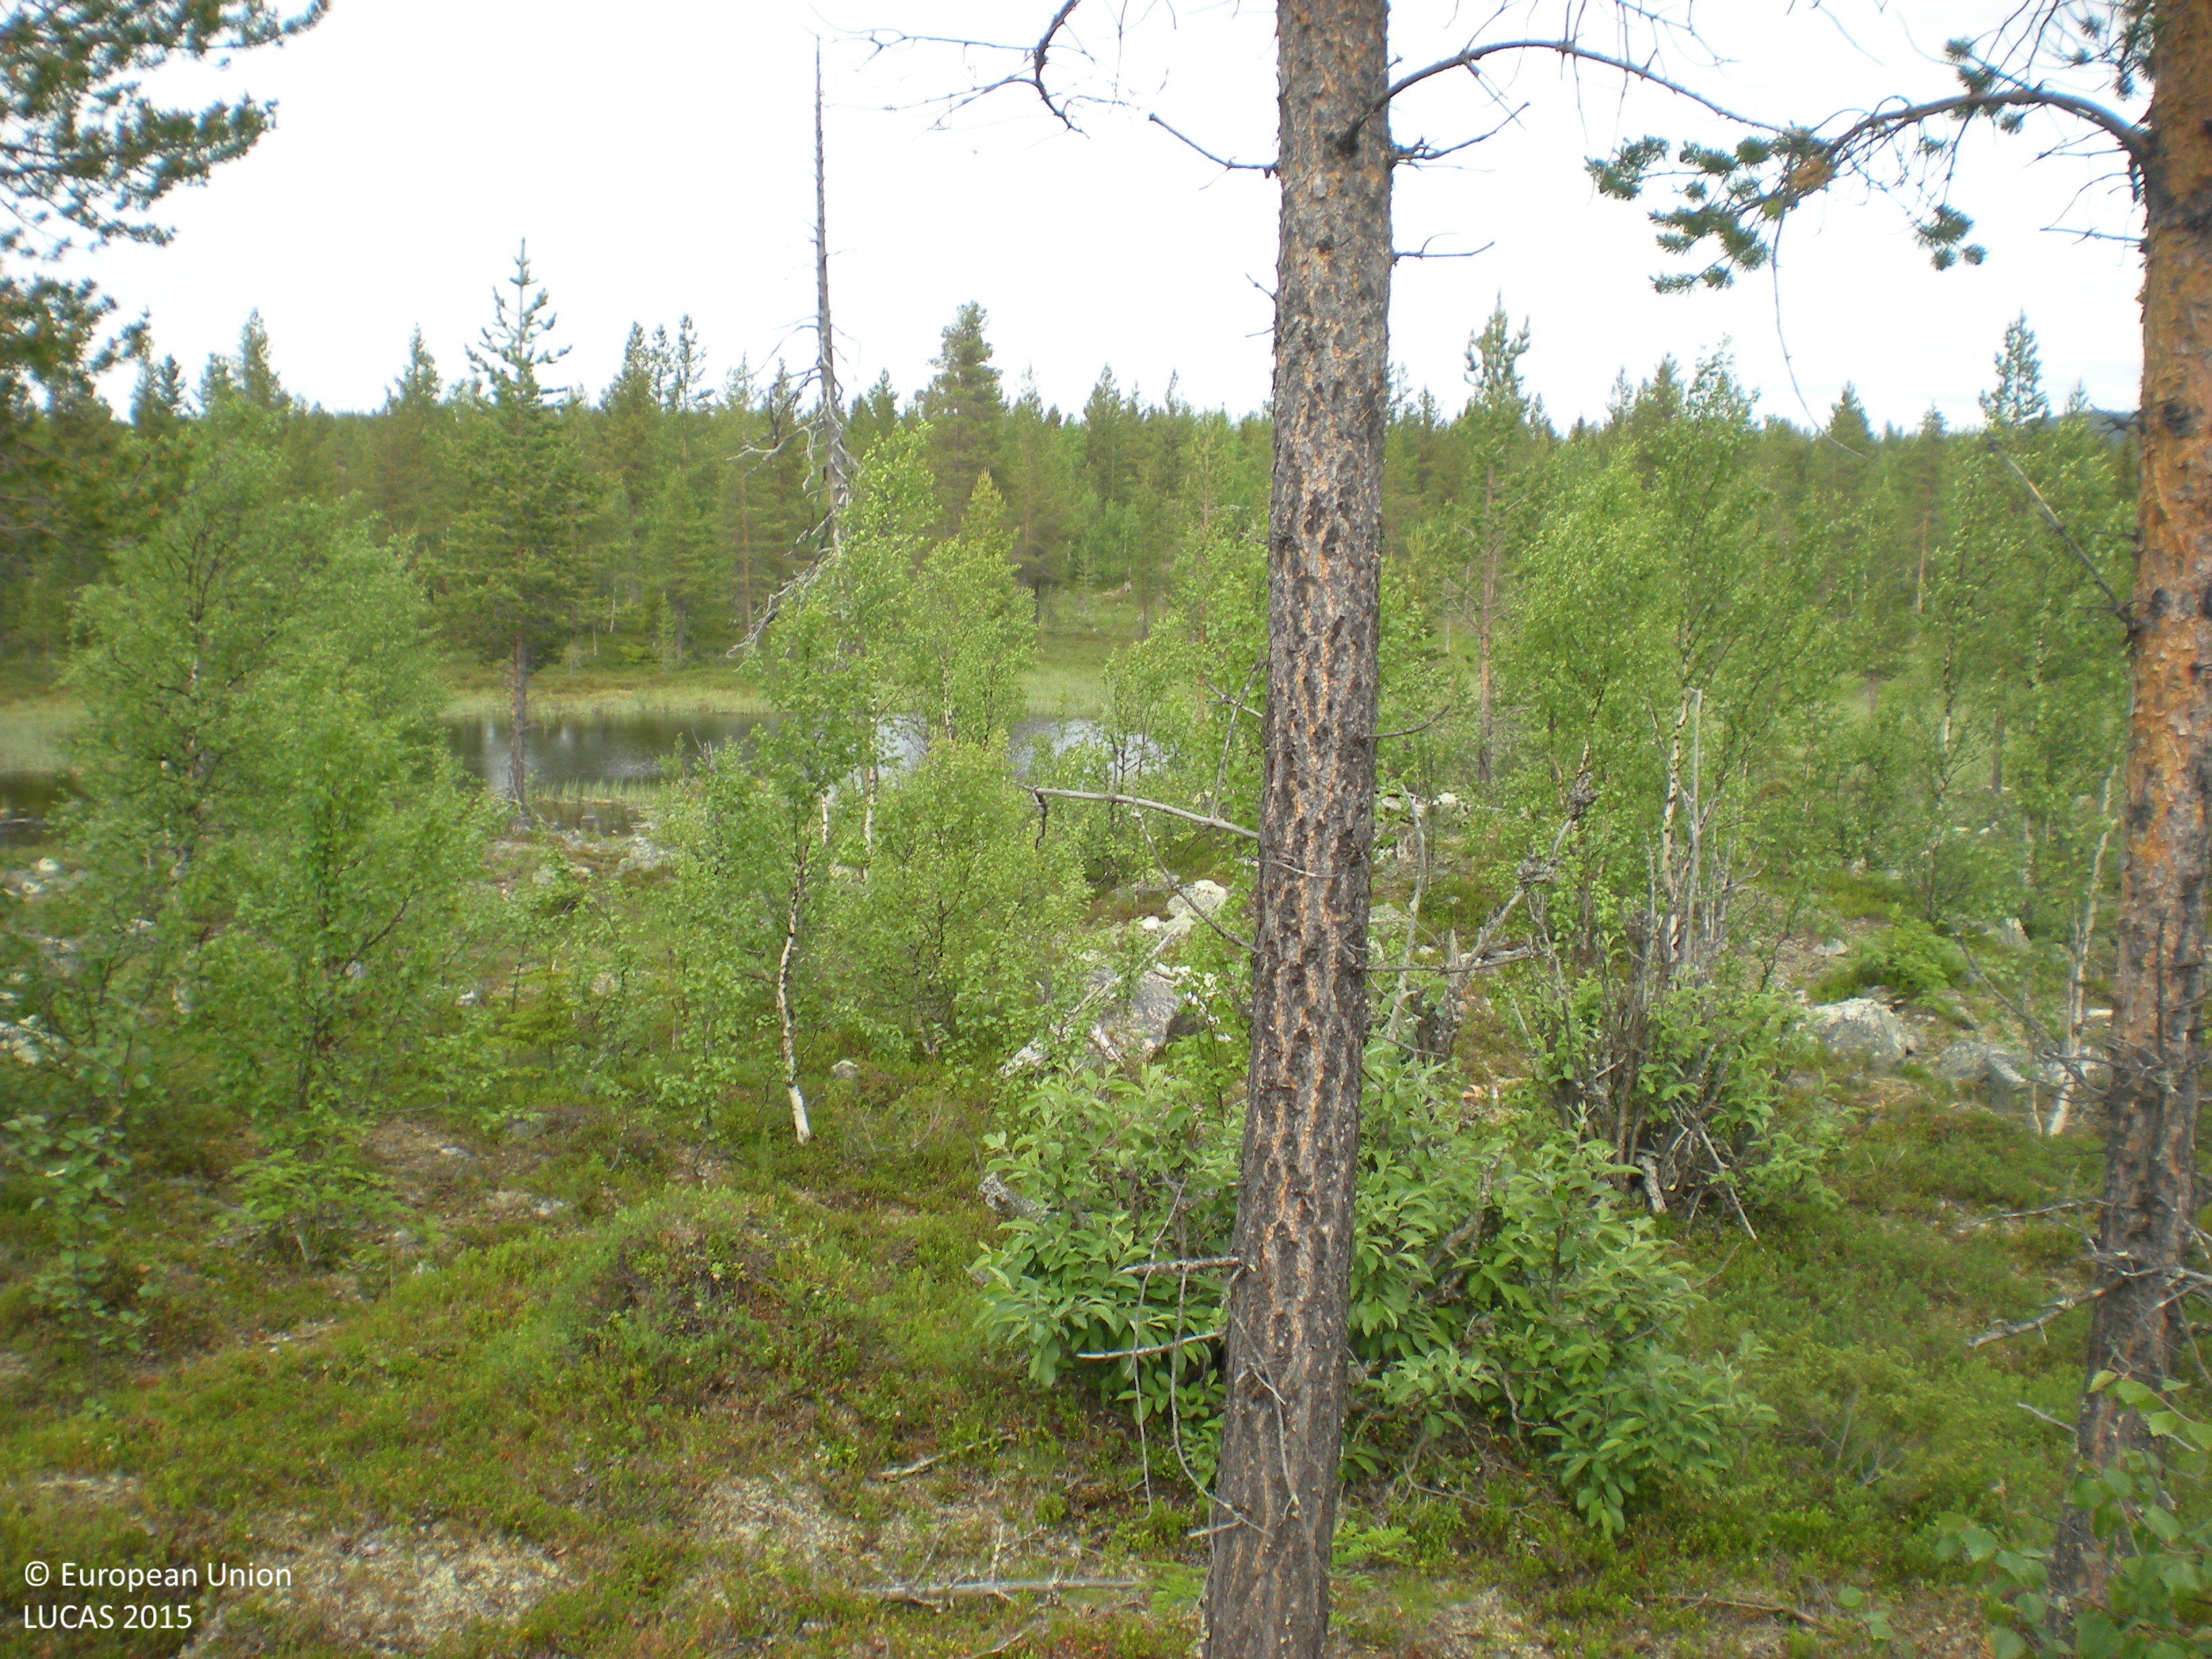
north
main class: Woodland
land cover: Spruce dominated mixed woodland
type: boreal forest
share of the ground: 25 - 50 %
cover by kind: shrubs 40 %, coniferous forest trees 25 %, broadleaved forest trees 20 %, consolidated bare surface 10 %, lichens and mosses 5 %
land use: Forestry
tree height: > 5 m
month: July
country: SE
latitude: 65.5951
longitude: 17.2256
